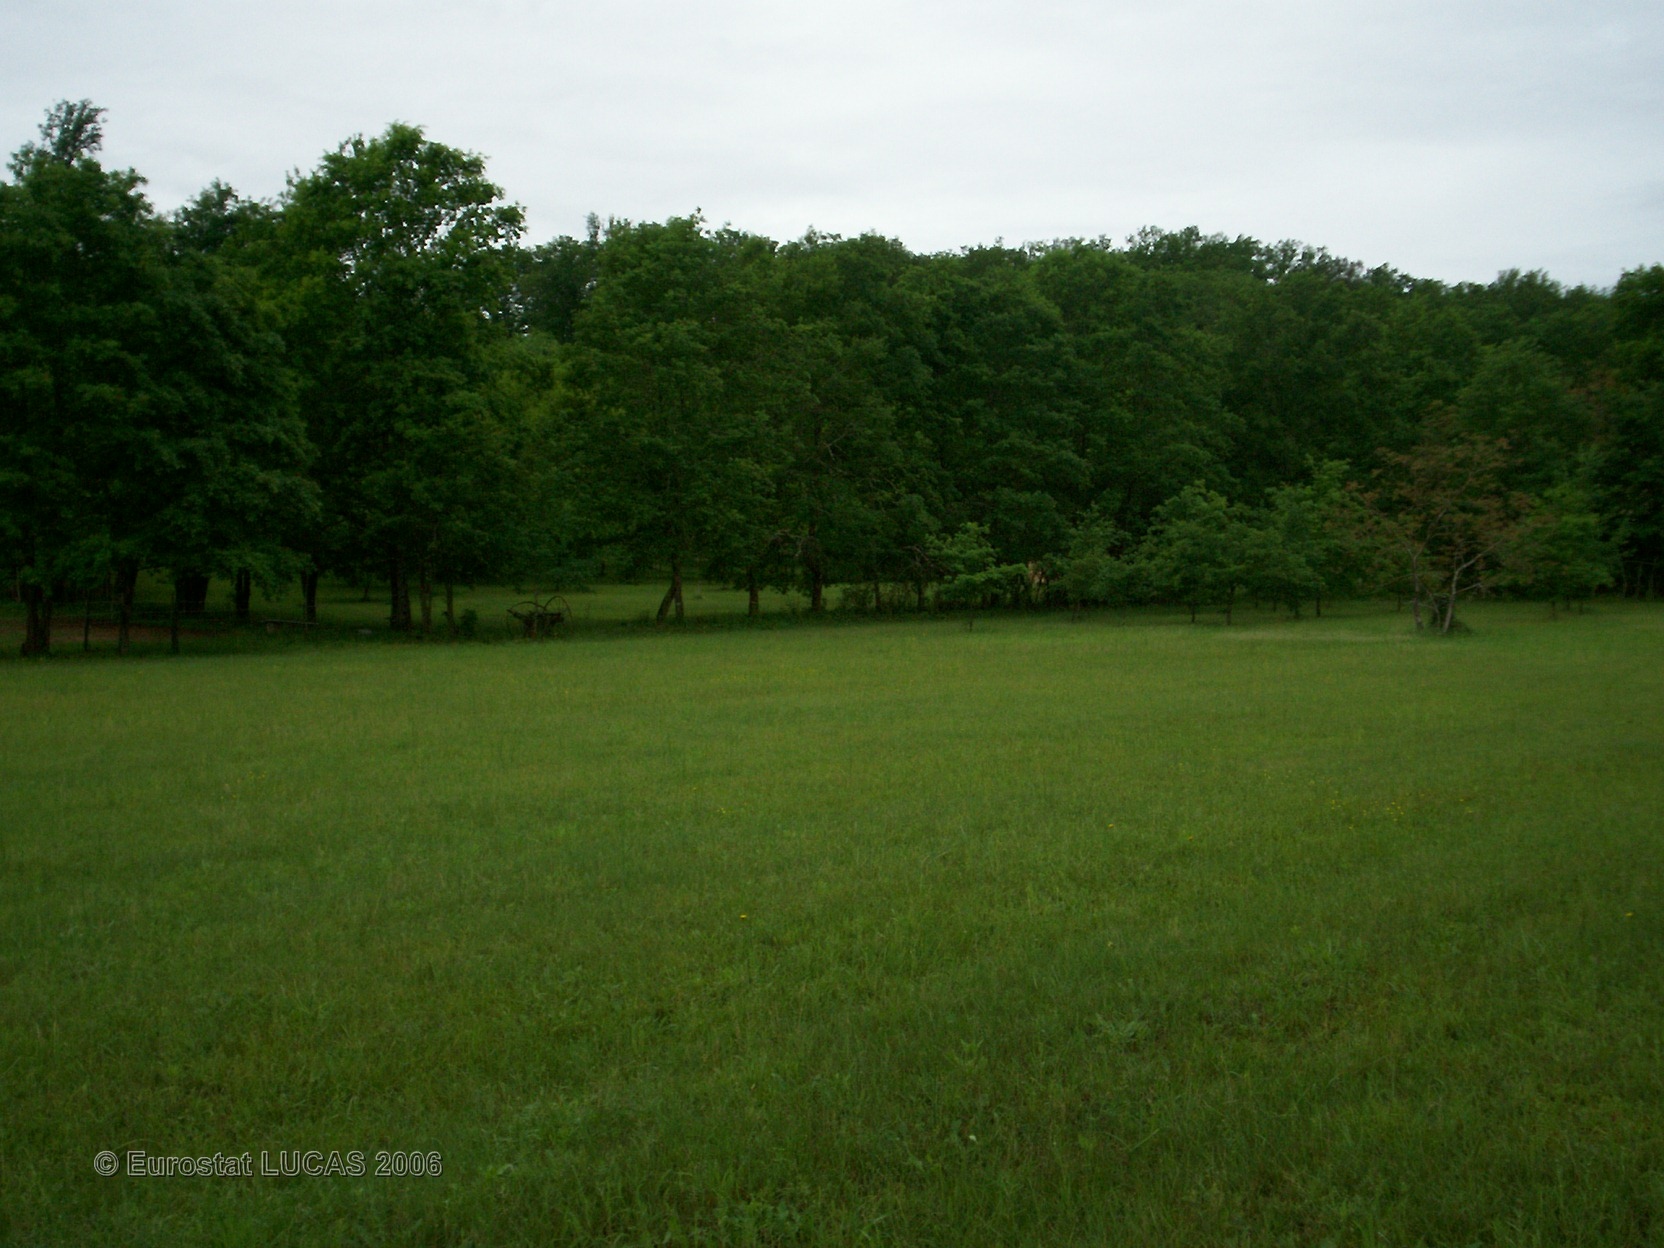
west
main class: Grassland
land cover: Grassland without tree/shrub cover
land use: Agriculture (excluding fallow land and kitchen gardens)
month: May
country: FR
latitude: 44.7876
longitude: 1.3635
